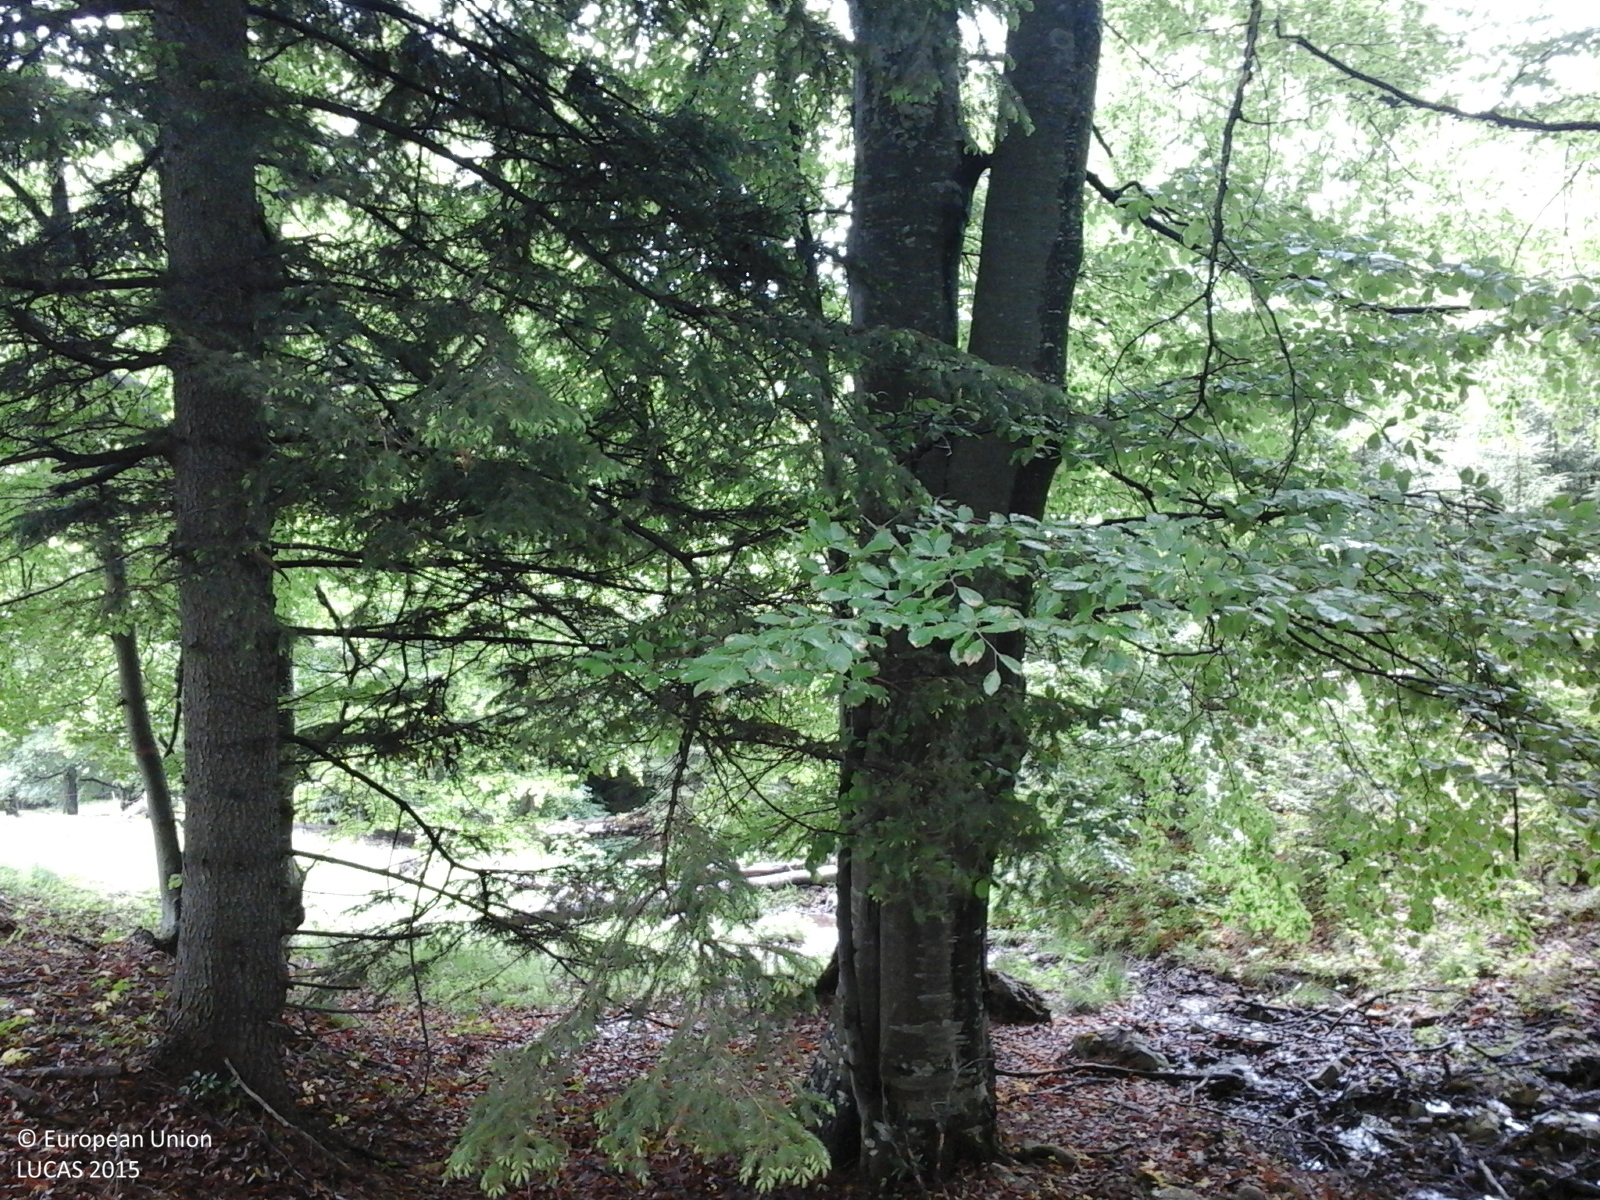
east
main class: Woodland
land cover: Other mixed woodland
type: mountainous beech forest
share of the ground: > 75 %
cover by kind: broadleaved forest trees 60 %, coniferous forest trees 40 %
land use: Forestry
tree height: > 5 m
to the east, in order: Other mixed woodland; Grassland without tree/shrub cover; Other mixed woodland; Rivers and streams; Spruce dominated mixed woodland
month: May
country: RO
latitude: 45.5006
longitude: 26.0210
